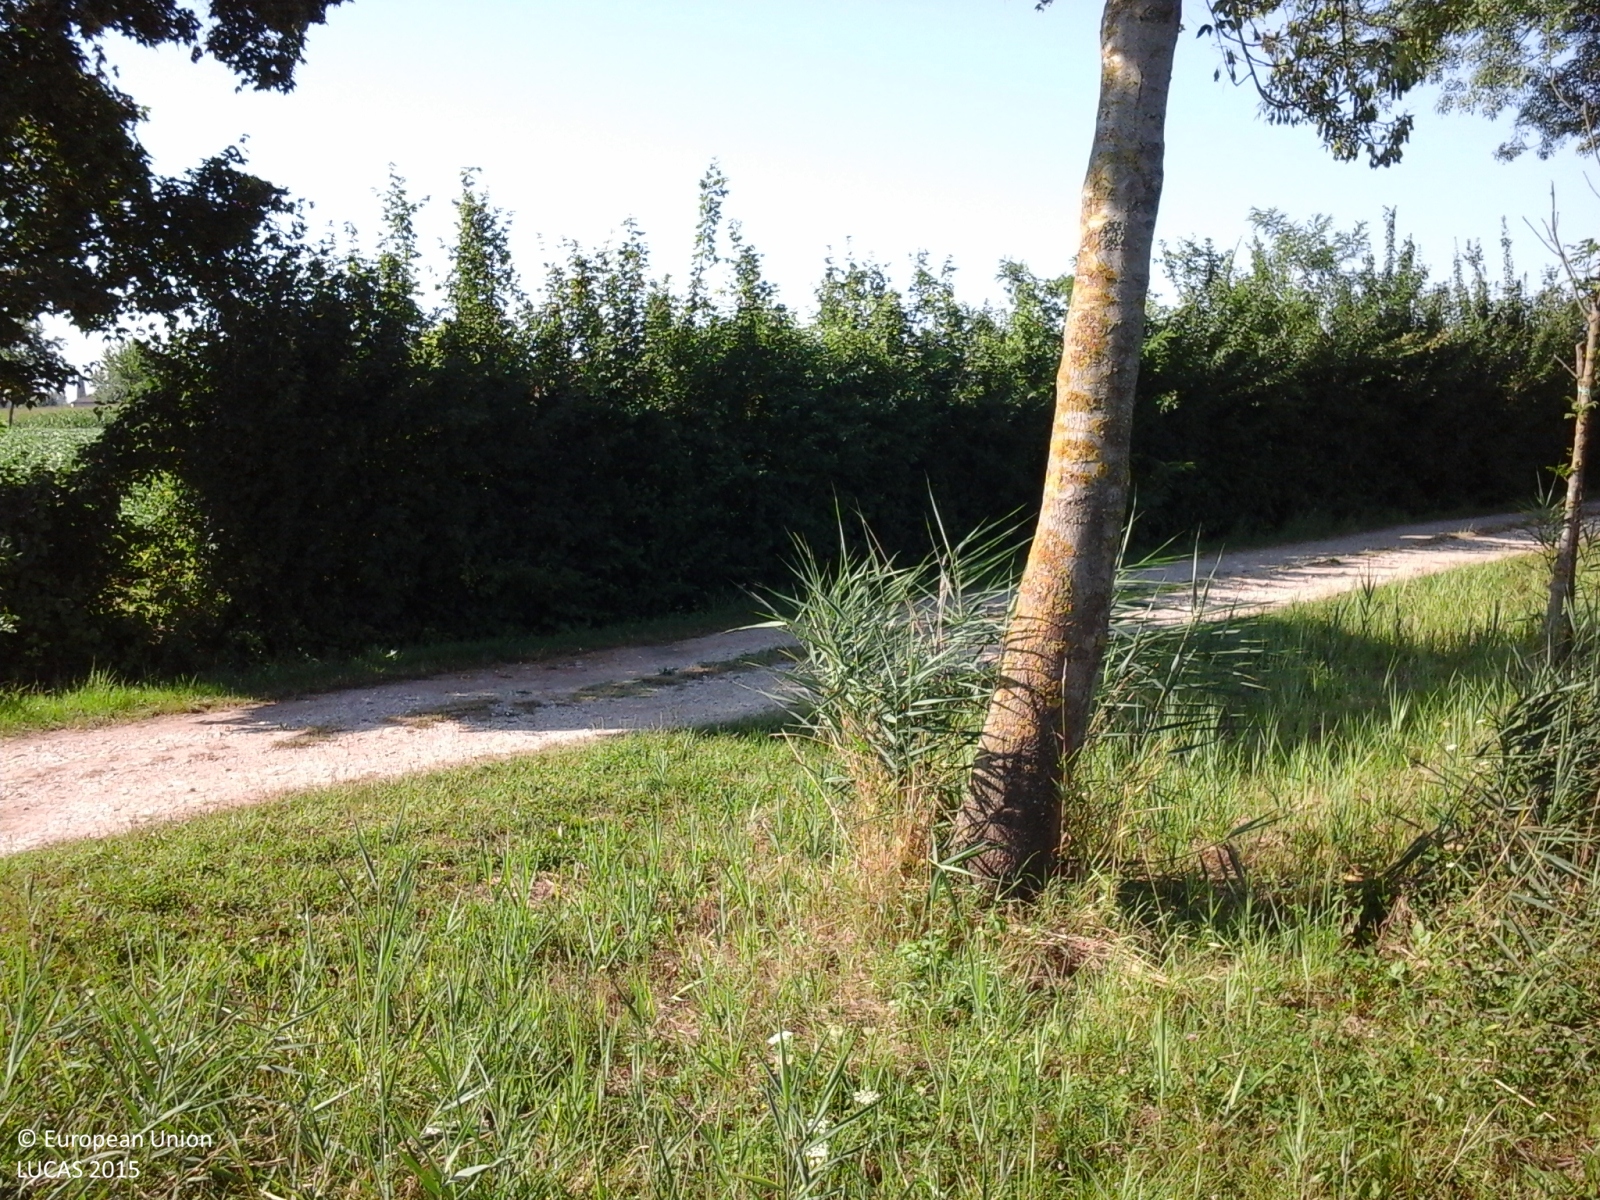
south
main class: Cropland
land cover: Soya
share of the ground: > 75 %
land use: Agriculture (excluding fallow land and kitchen gardens)
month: July
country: IT
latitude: 45.7307
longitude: 12.3482
